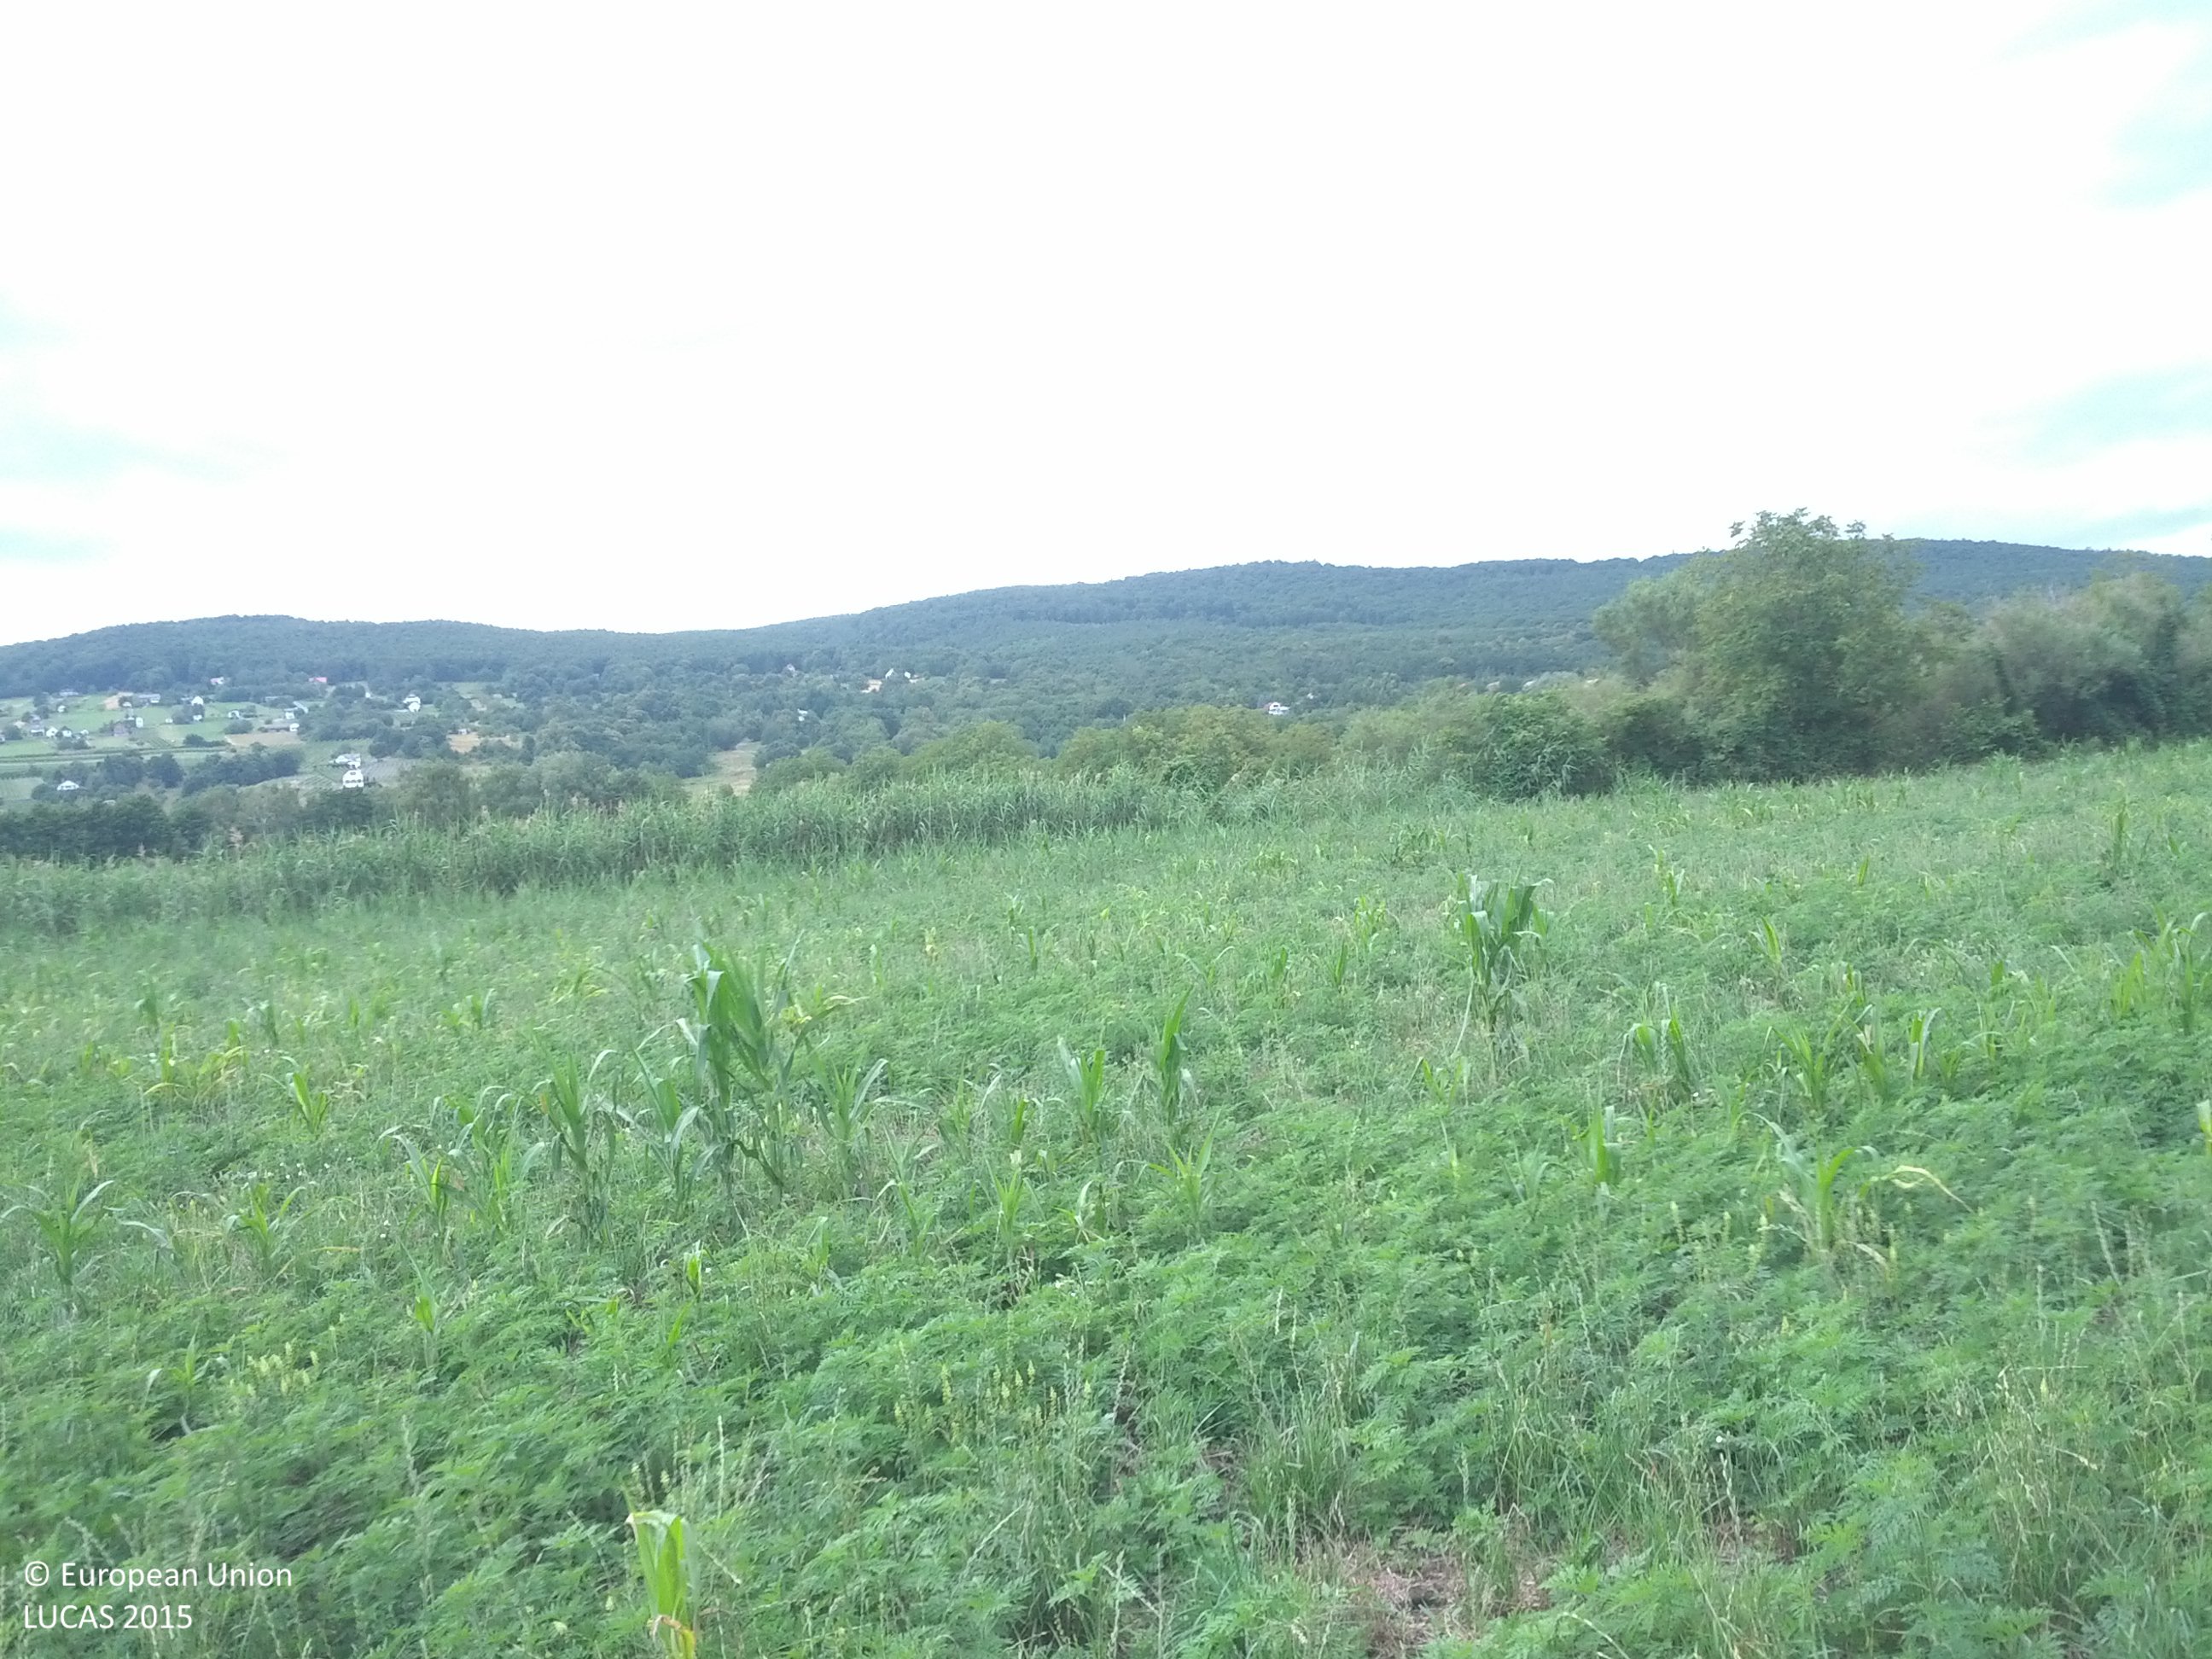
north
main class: Cropland
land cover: Temporary grasslands
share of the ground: > 75 %
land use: Agriculture (excluding fallow land and kitchen gardens)
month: July
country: AT
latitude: 47.3112
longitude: 16.4717
